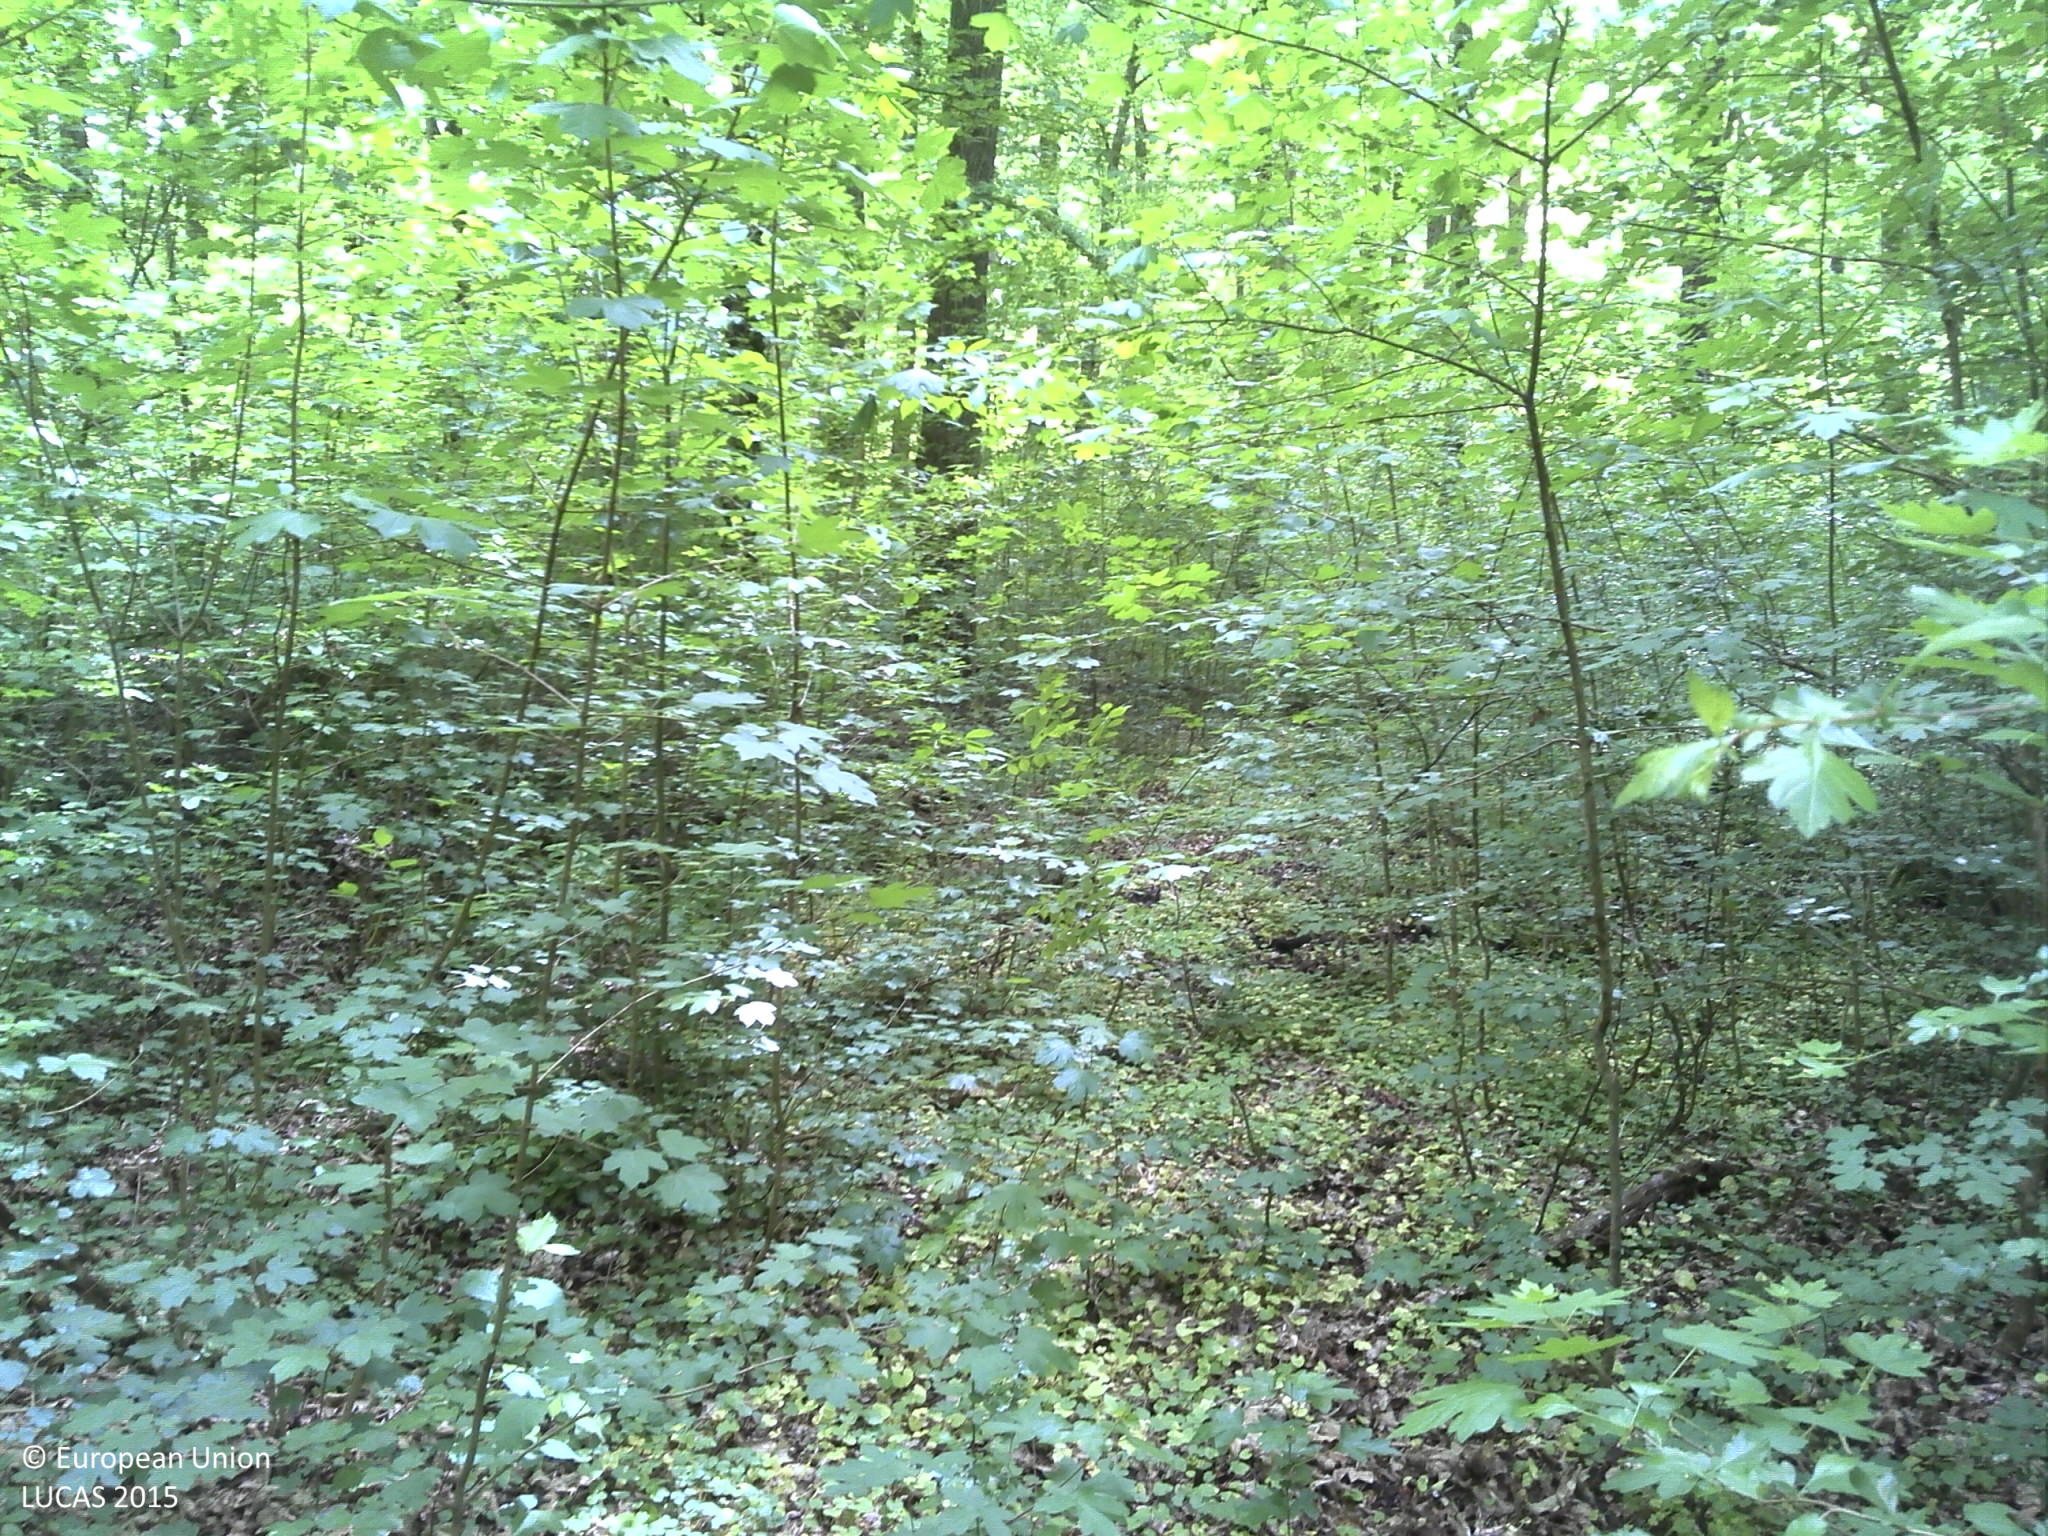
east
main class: Woodland
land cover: Broadleaved woodland
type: mesophytic deciduous forest
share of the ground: > 75 %
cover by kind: broadleaved forest trees 100 %
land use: Forestry
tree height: > 5 m
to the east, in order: Broadleaved woodland; Rivers and streams
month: April
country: HR
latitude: 45.0969
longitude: 18.8381
